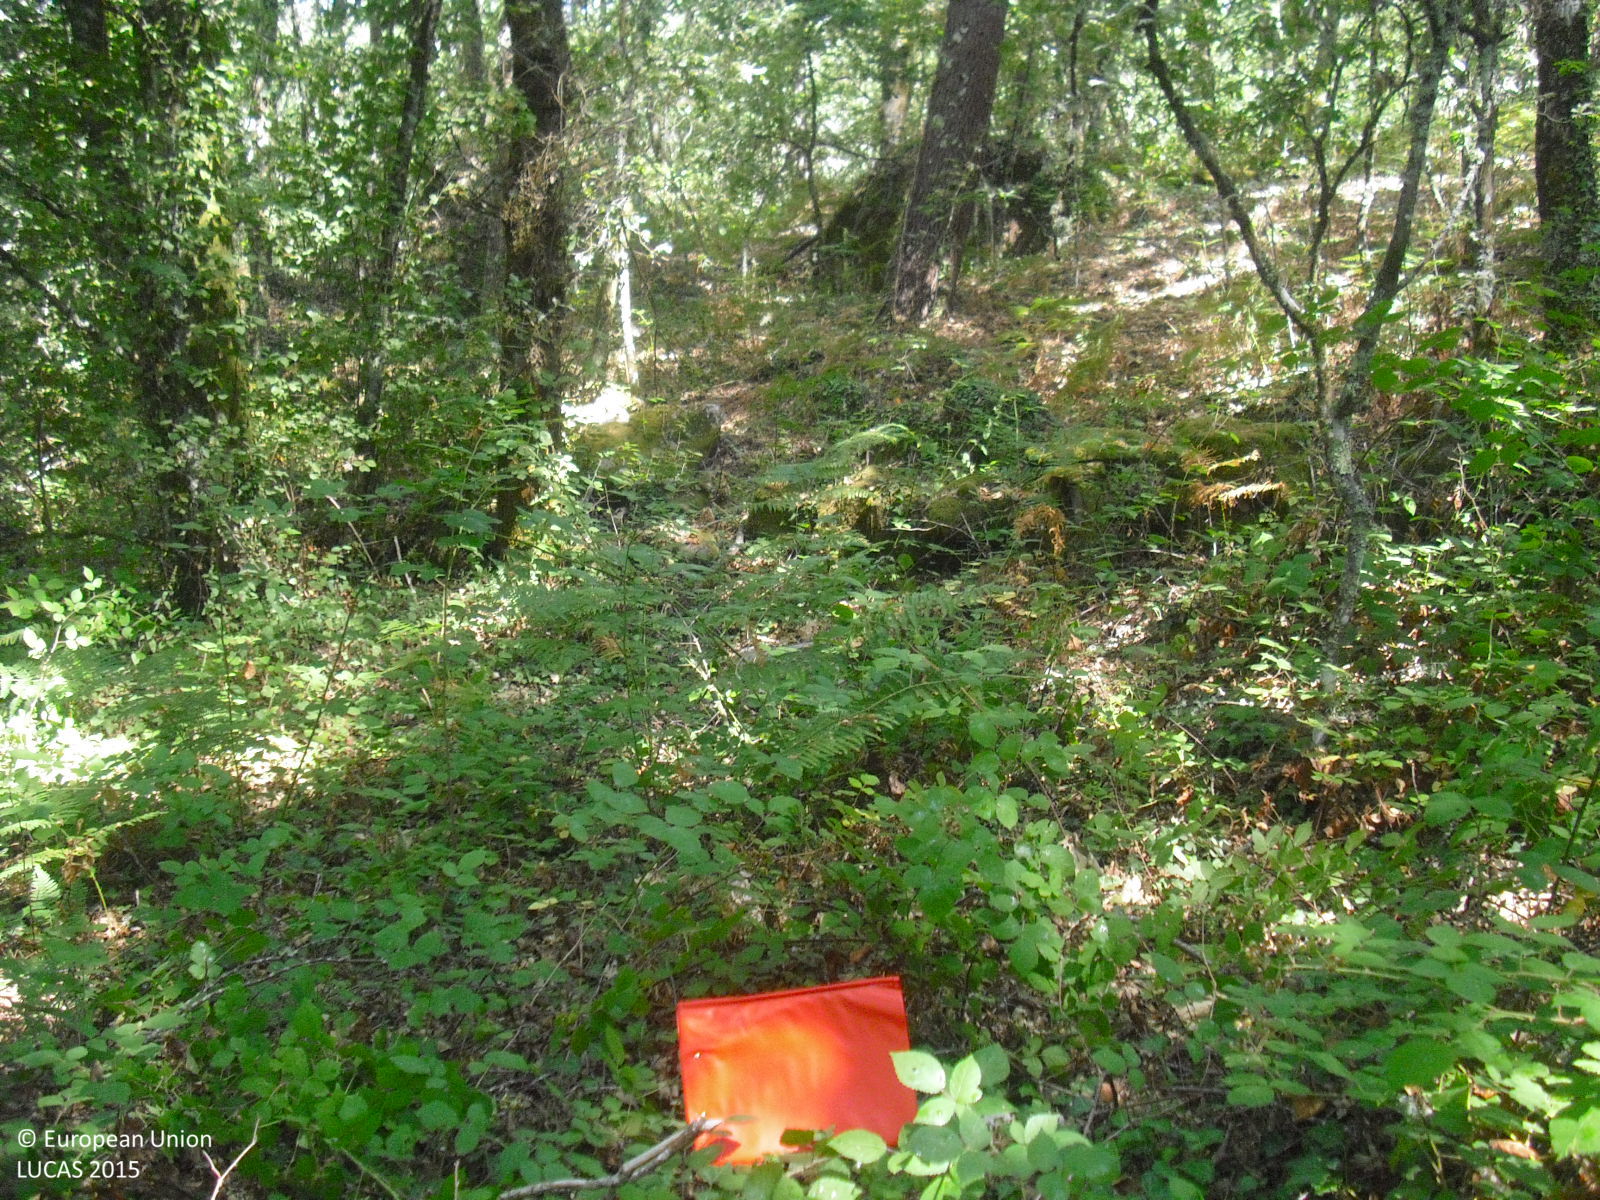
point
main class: Woodland
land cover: Broadleaved woodland
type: thermophilous deciduous forest
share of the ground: > 75 %
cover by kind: broadleaved forest trees 90 %, shrubs 10 %
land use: Forestry
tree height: > 5 m
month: July
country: ES
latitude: 42.3817
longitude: -7.7463
